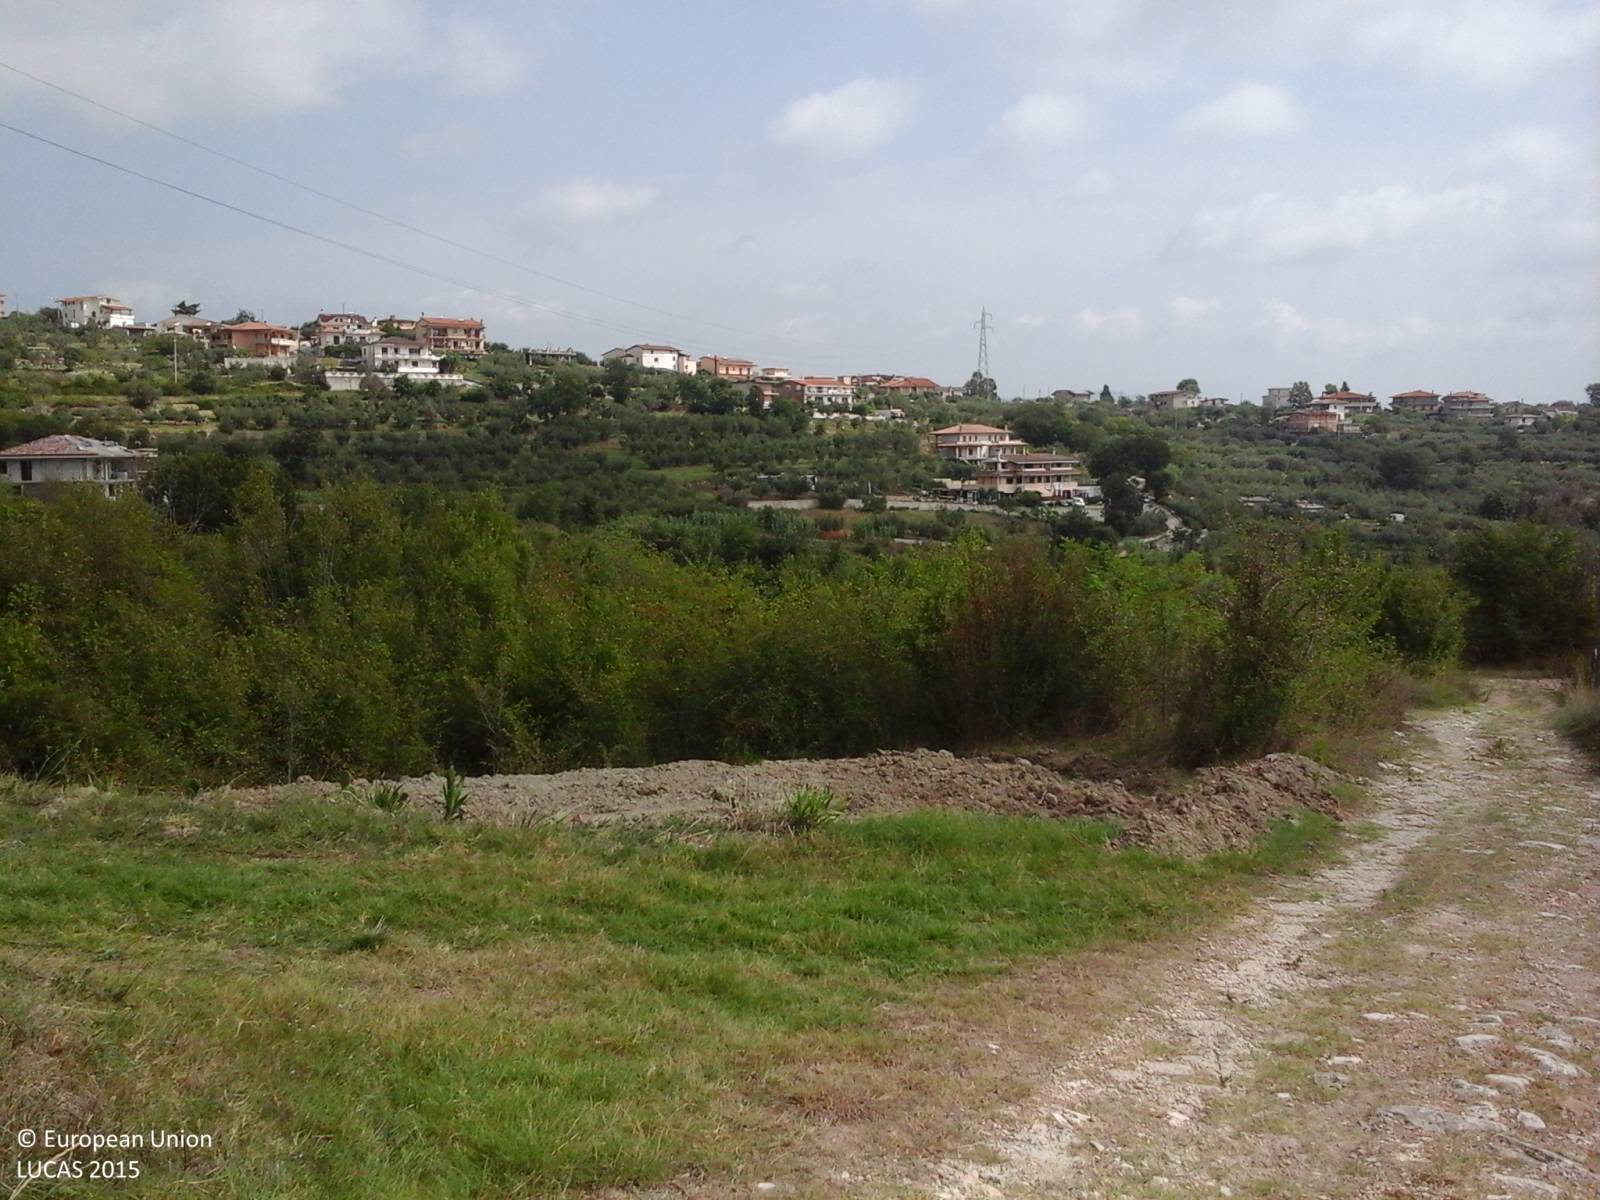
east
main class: Grassland
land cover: Grassland without tree/shrub cover
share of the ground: > 75 %
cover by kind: herbaceous plants 100 %
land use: Abandoned areas
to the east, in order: Grassland without tree/shrub cover; Shrubland without tree cover; Fences; Tracks; Shrubland without tree cover; Rocks and stones; Other bare soil; Grassland without tree/shrub cover
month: September
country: IT
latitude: 41.2841
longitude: 13.6986
